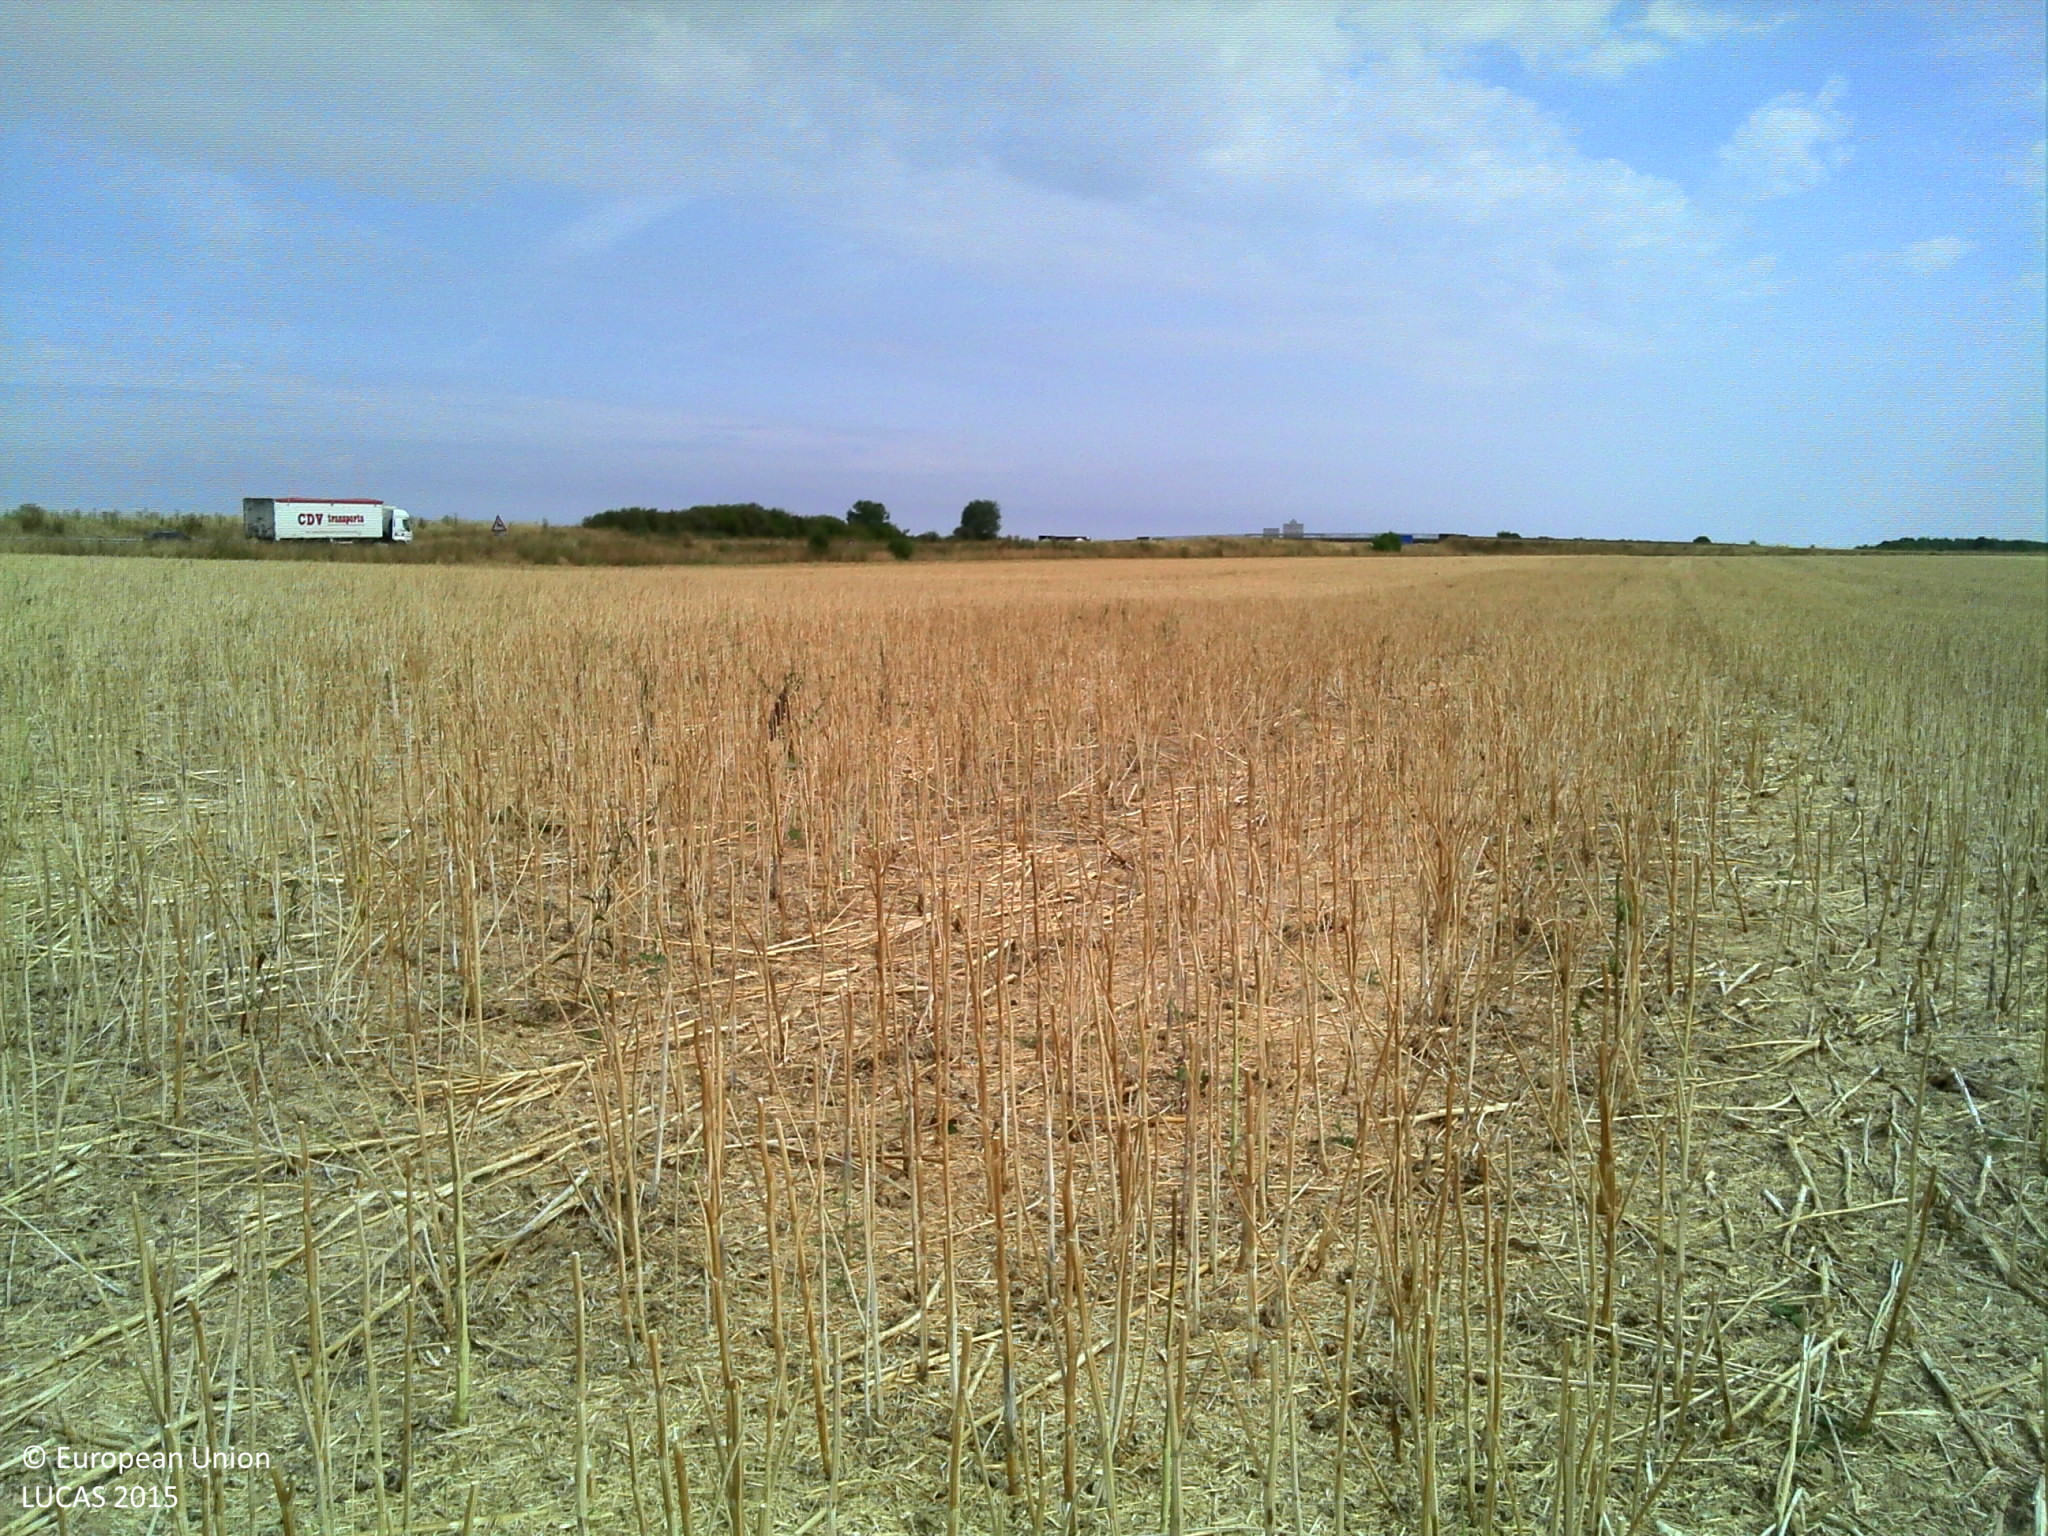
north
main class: Cropland
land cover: Rape and turnip rape
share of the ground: > 75 %
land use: Agriculture (excluding fallow land and kitchen gardens)
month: July
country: FR
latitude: 48.0620
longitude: 3.1095
